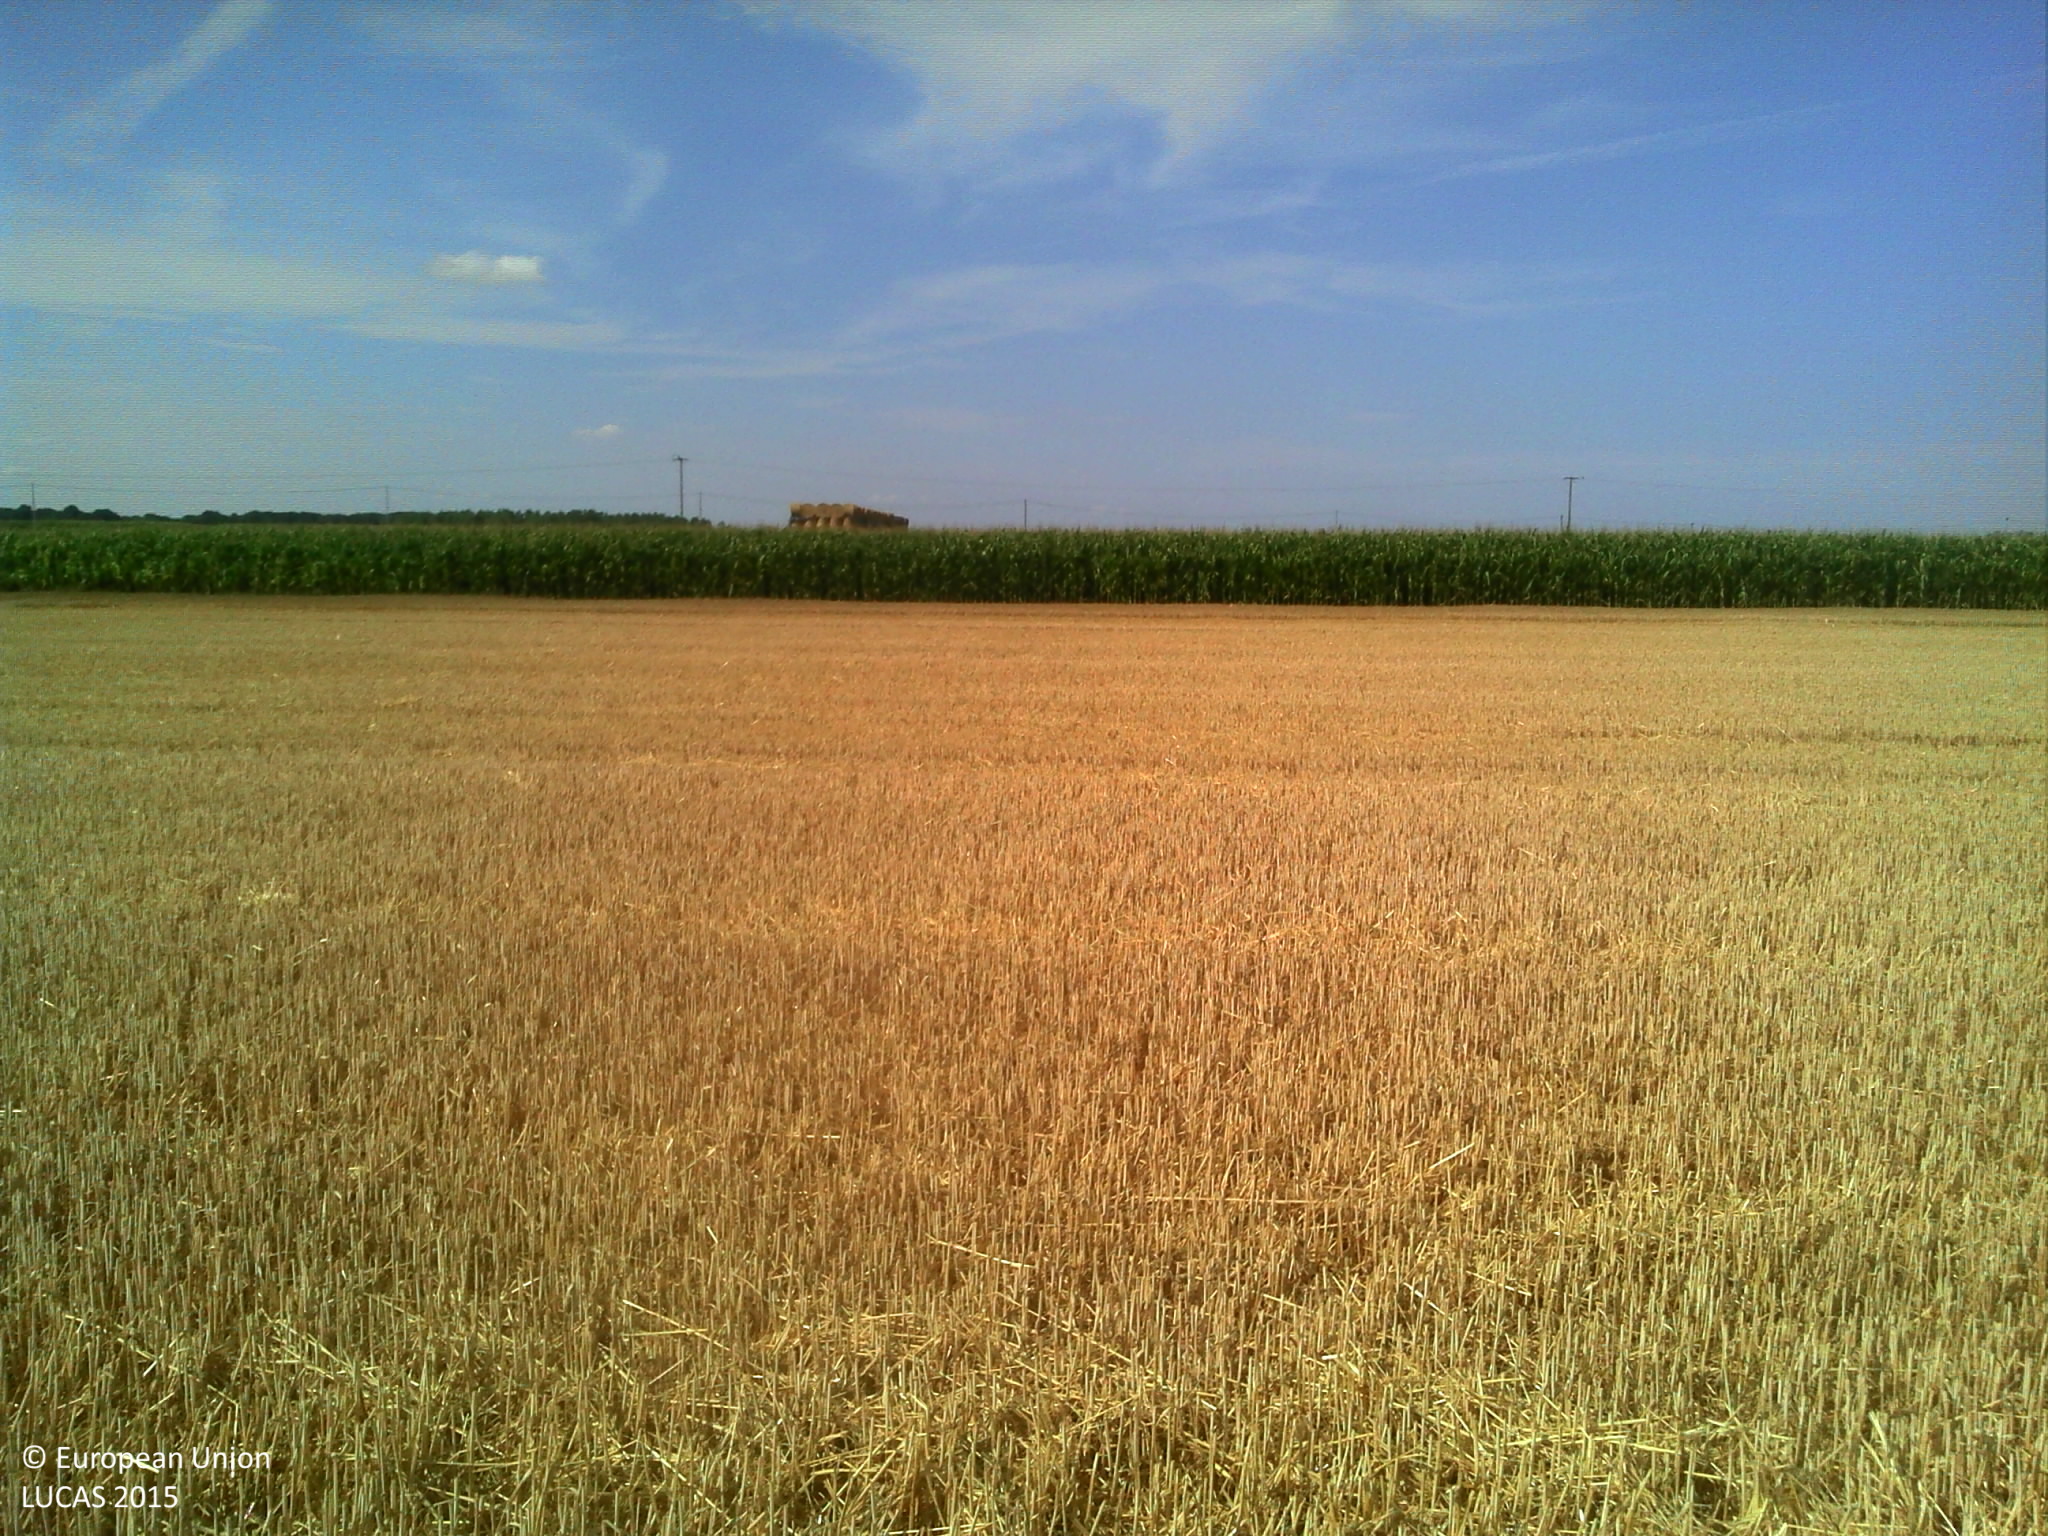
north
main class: Cropland
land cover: Common wheat
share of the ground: > 75 %
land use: Agriculture (excluding fallow land and kitchen gardens)
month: July
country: FR
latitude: 46.9198
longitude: 4.9981
